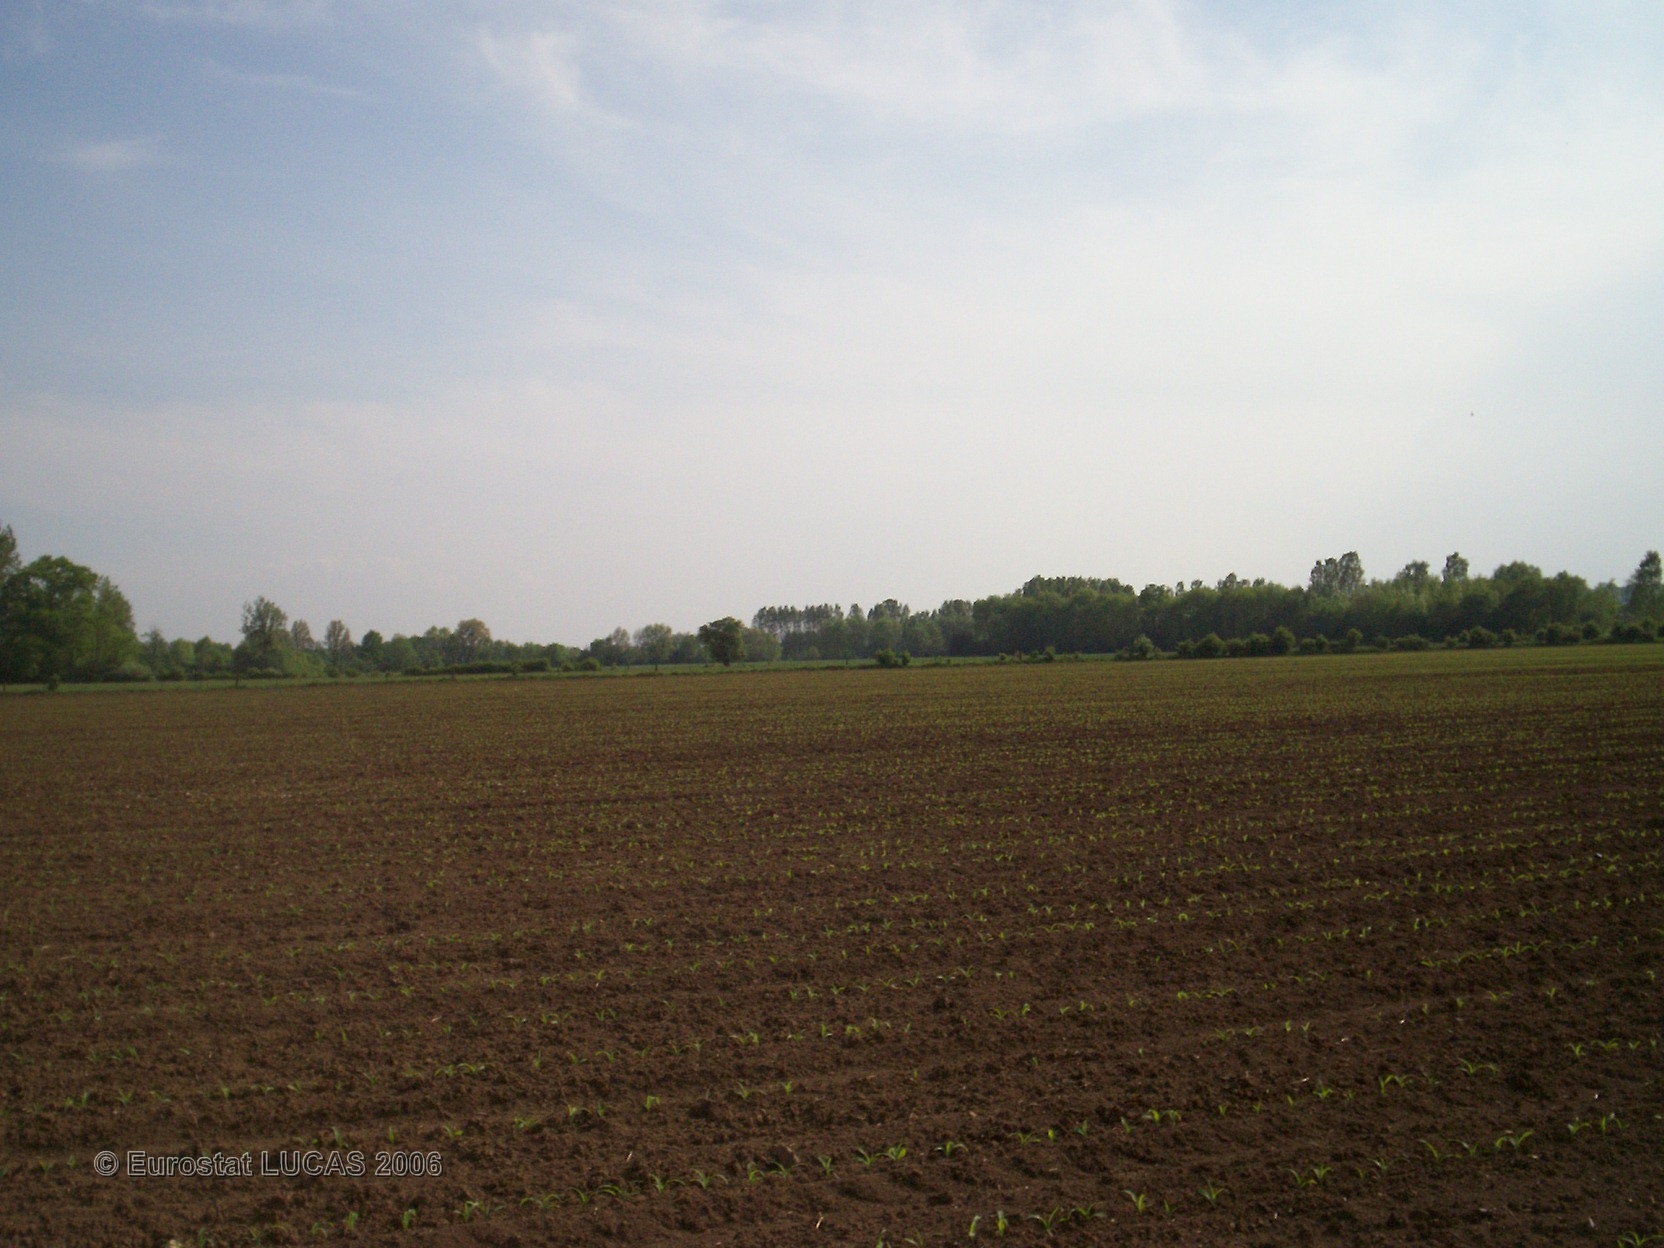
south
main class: Cropland
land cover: Maize
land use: Agriculture (excluding fallow land and kitchen gardens)
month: May
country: FR
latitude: 49.5915
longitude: 4.3099
